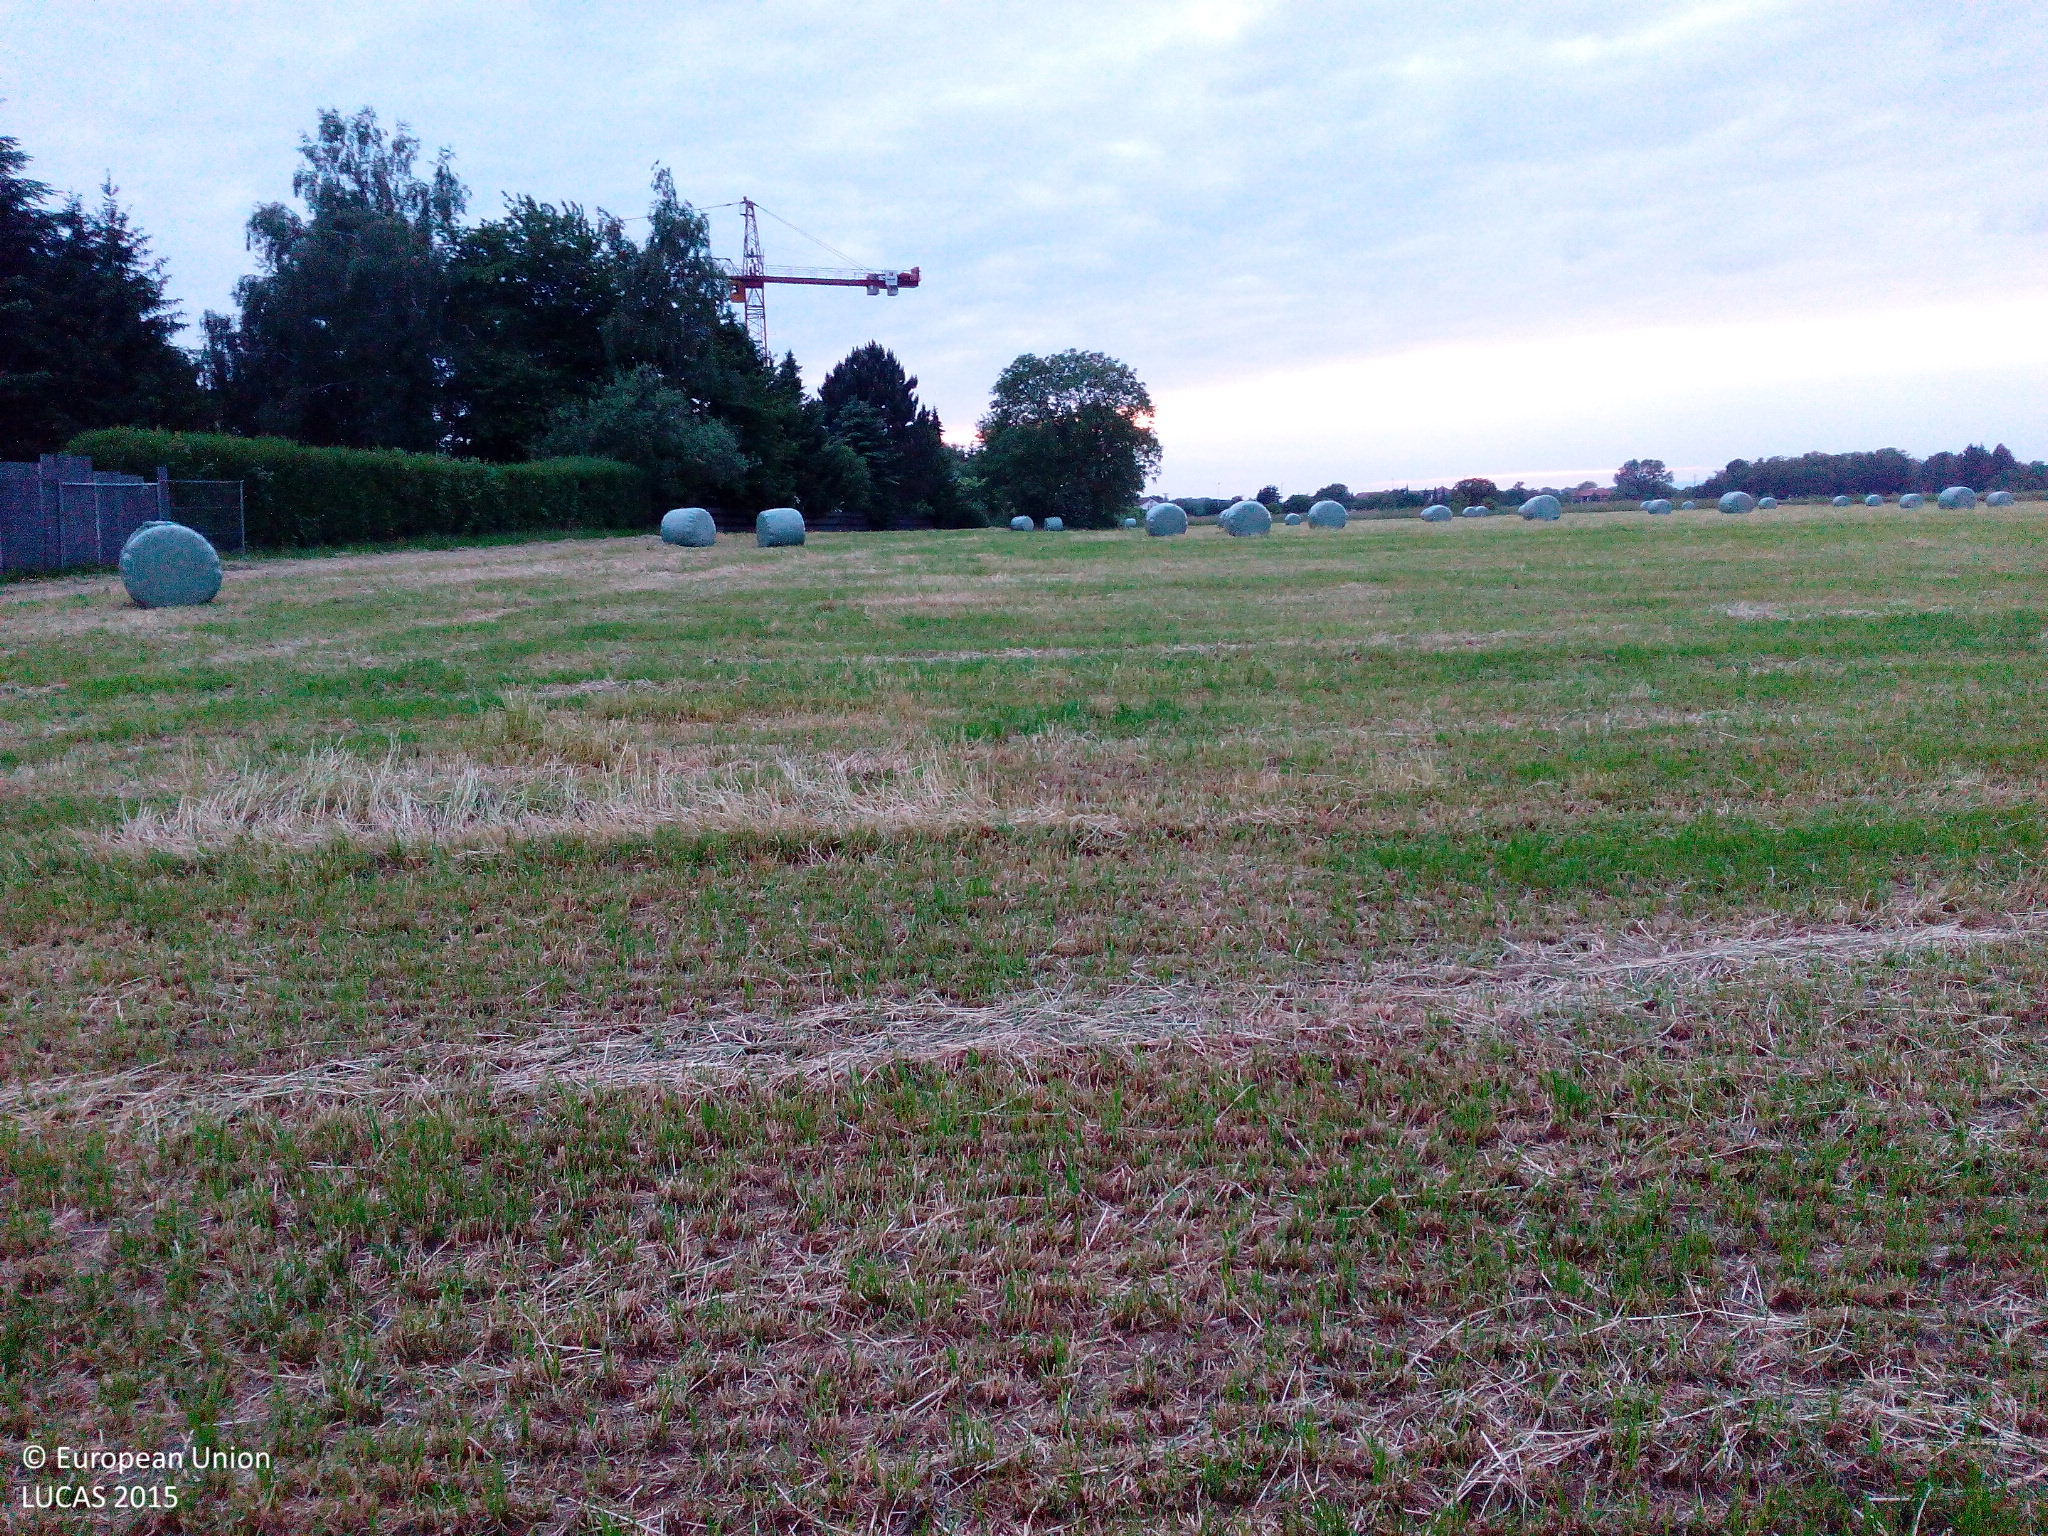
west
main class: Cropland
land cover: Temporary grasslands
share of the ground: 10 - 25 %
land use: Agriculture (excluding fallow land and kitchen gardens)
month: May
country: DE
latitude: 48.8201
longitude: 8.1620
